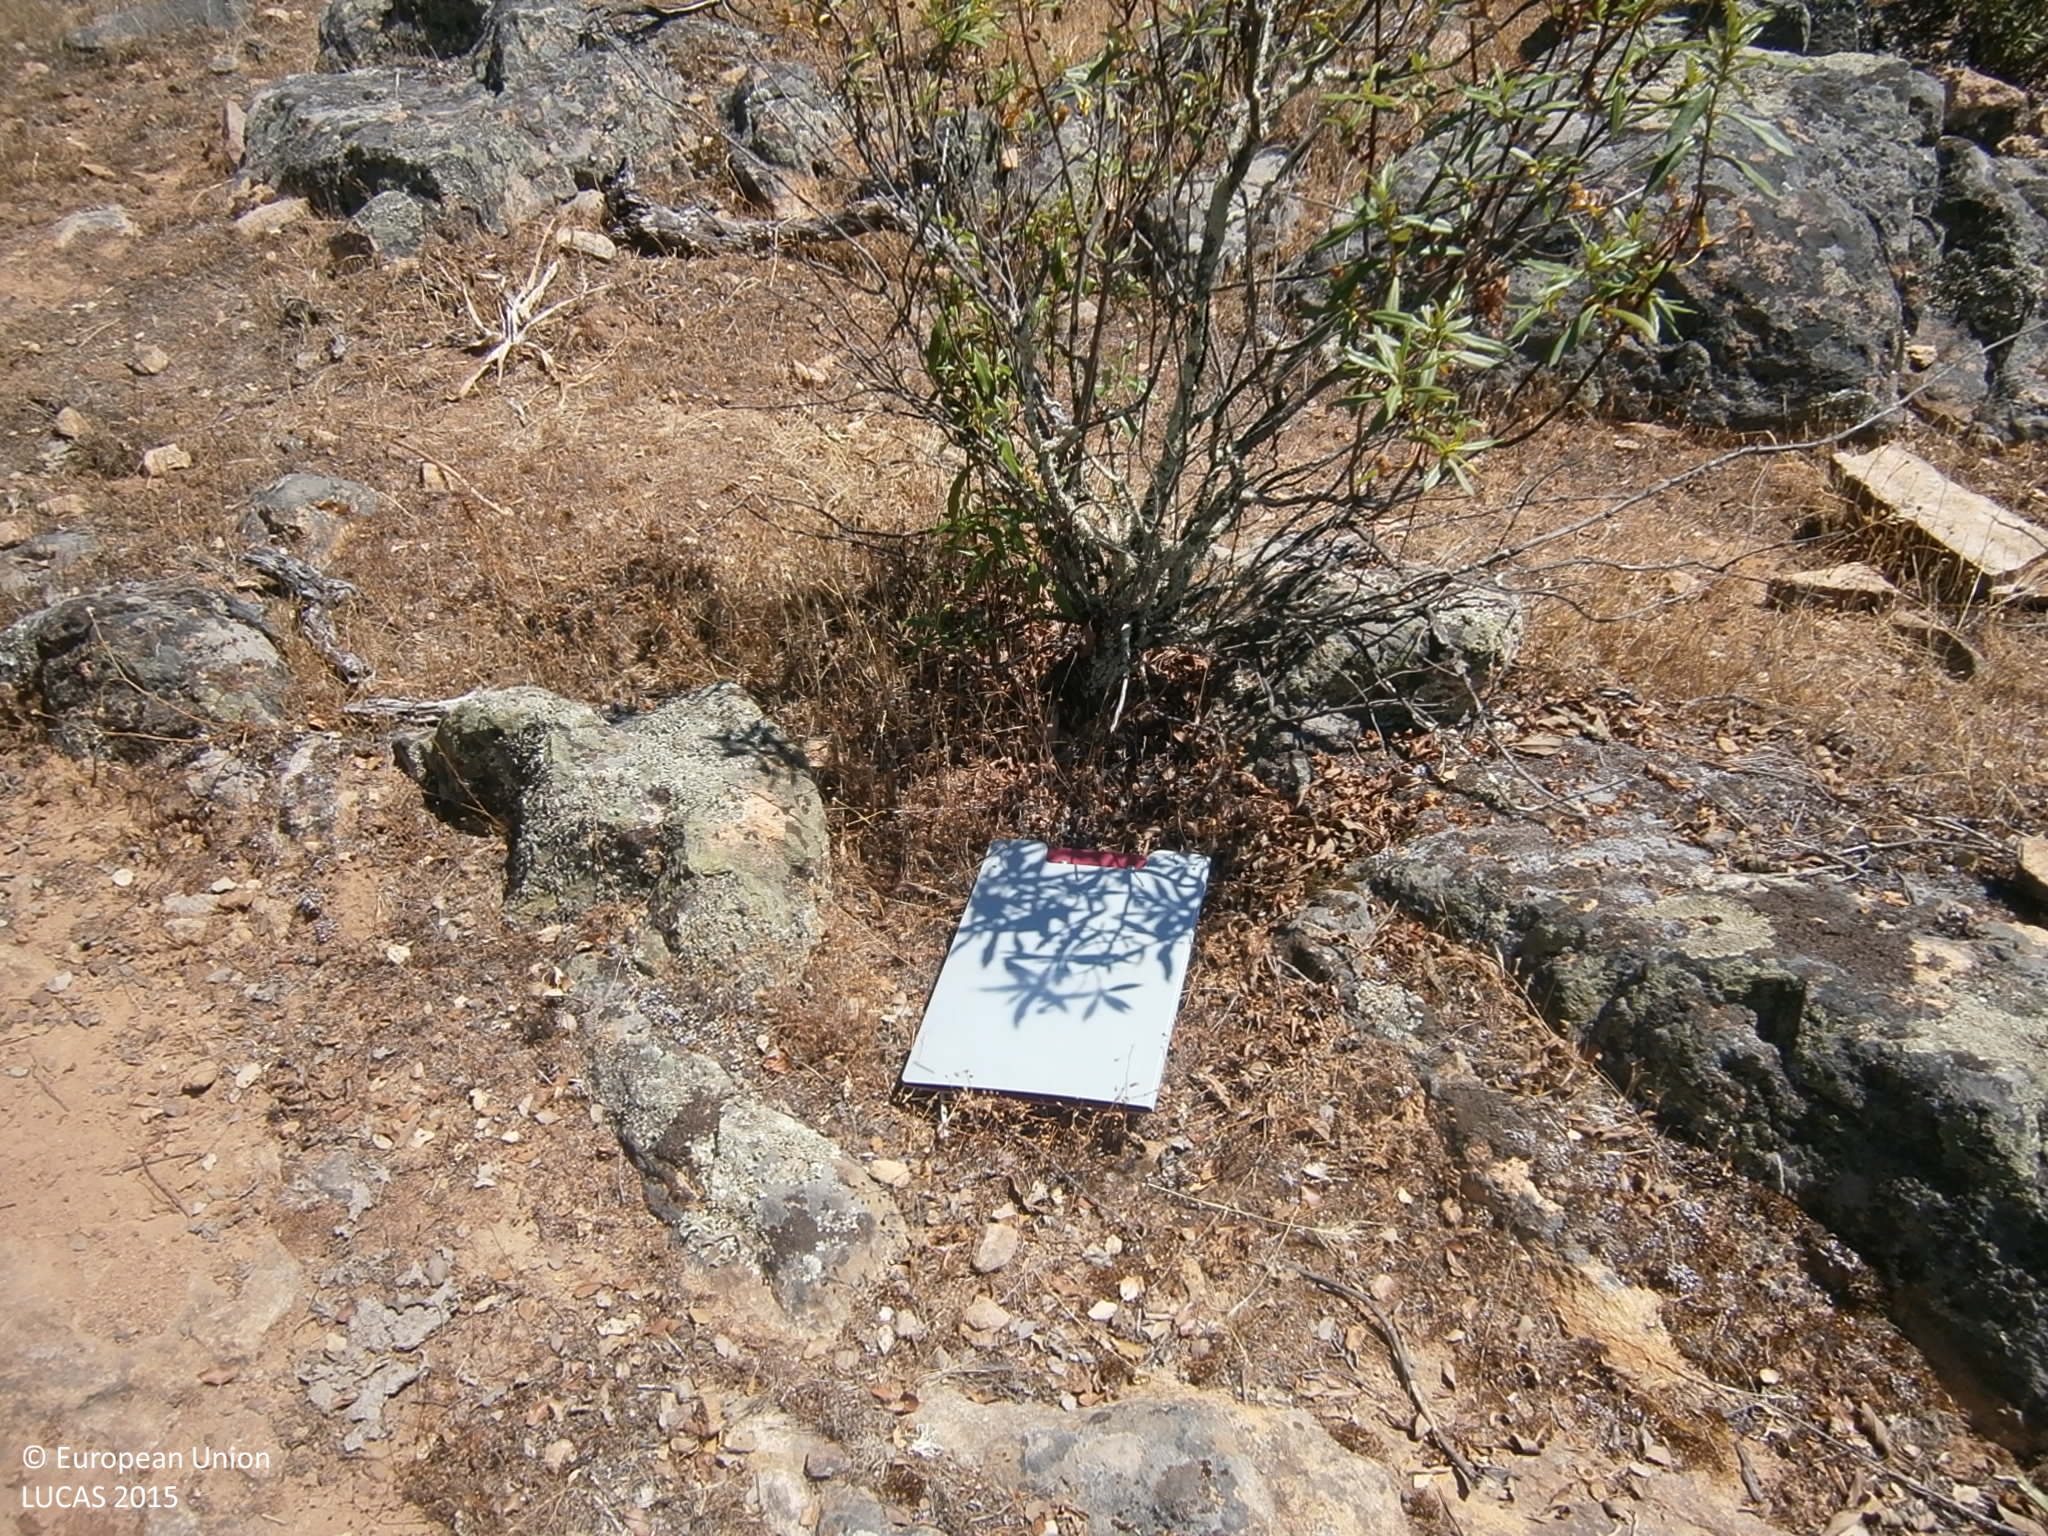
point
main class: Woodland
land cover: Broadleaved woodland
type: acidophilous oak and oak-birch forest
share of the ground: 25 - 50 %
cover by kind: broadleaved forest trees 40 %, herbaceous plants 25 %, shrubs 20 %, unconsolidated bare surface 15 %
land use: Agriculture (excluding fallow land and kitchen gardens)
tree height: > 5 m
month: June
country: ES
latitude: 38.5992
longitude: -6.9311
